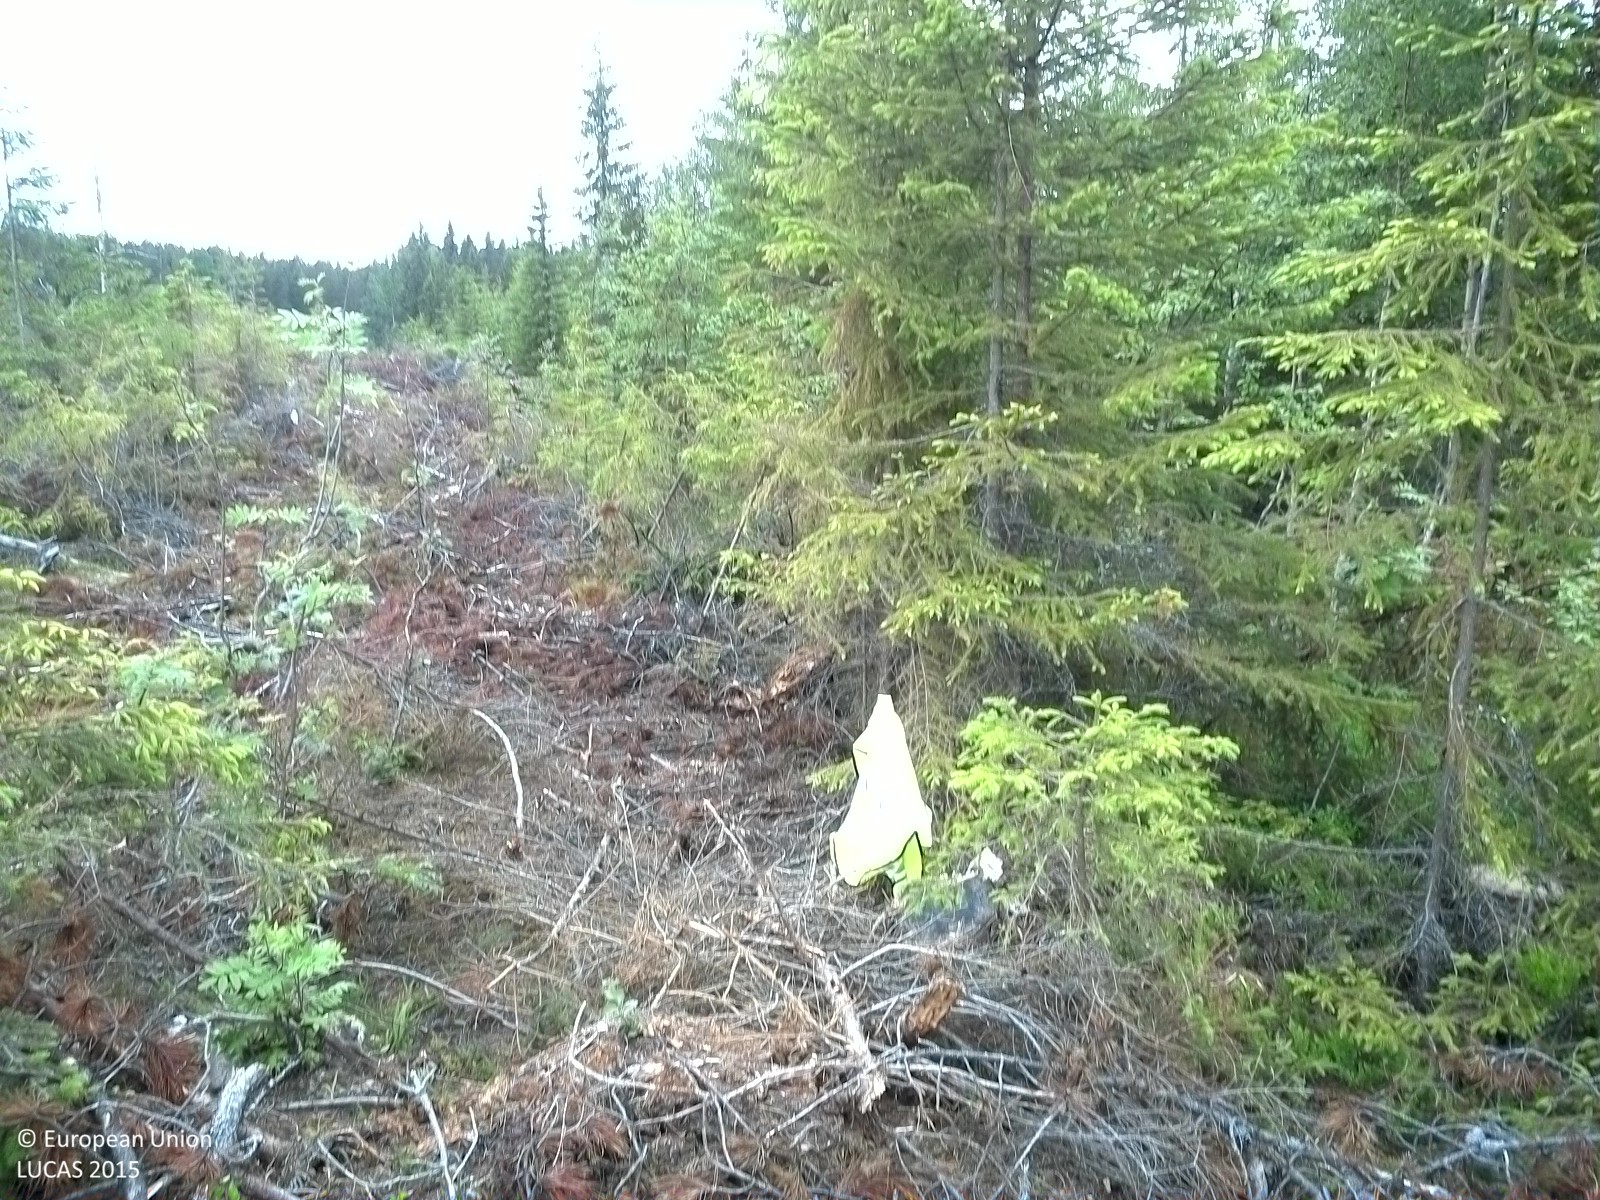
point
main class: Woodland
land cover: Other coniferous woodland
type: boreal forest
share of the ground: 10 - 25 %
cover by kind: coniferous forest trees 25 %, herbaceous plants 25 %
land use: Forestry
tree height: < 5 m
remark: Clear cut
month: June
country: SE
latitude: 62.0263
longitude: 16.3452
